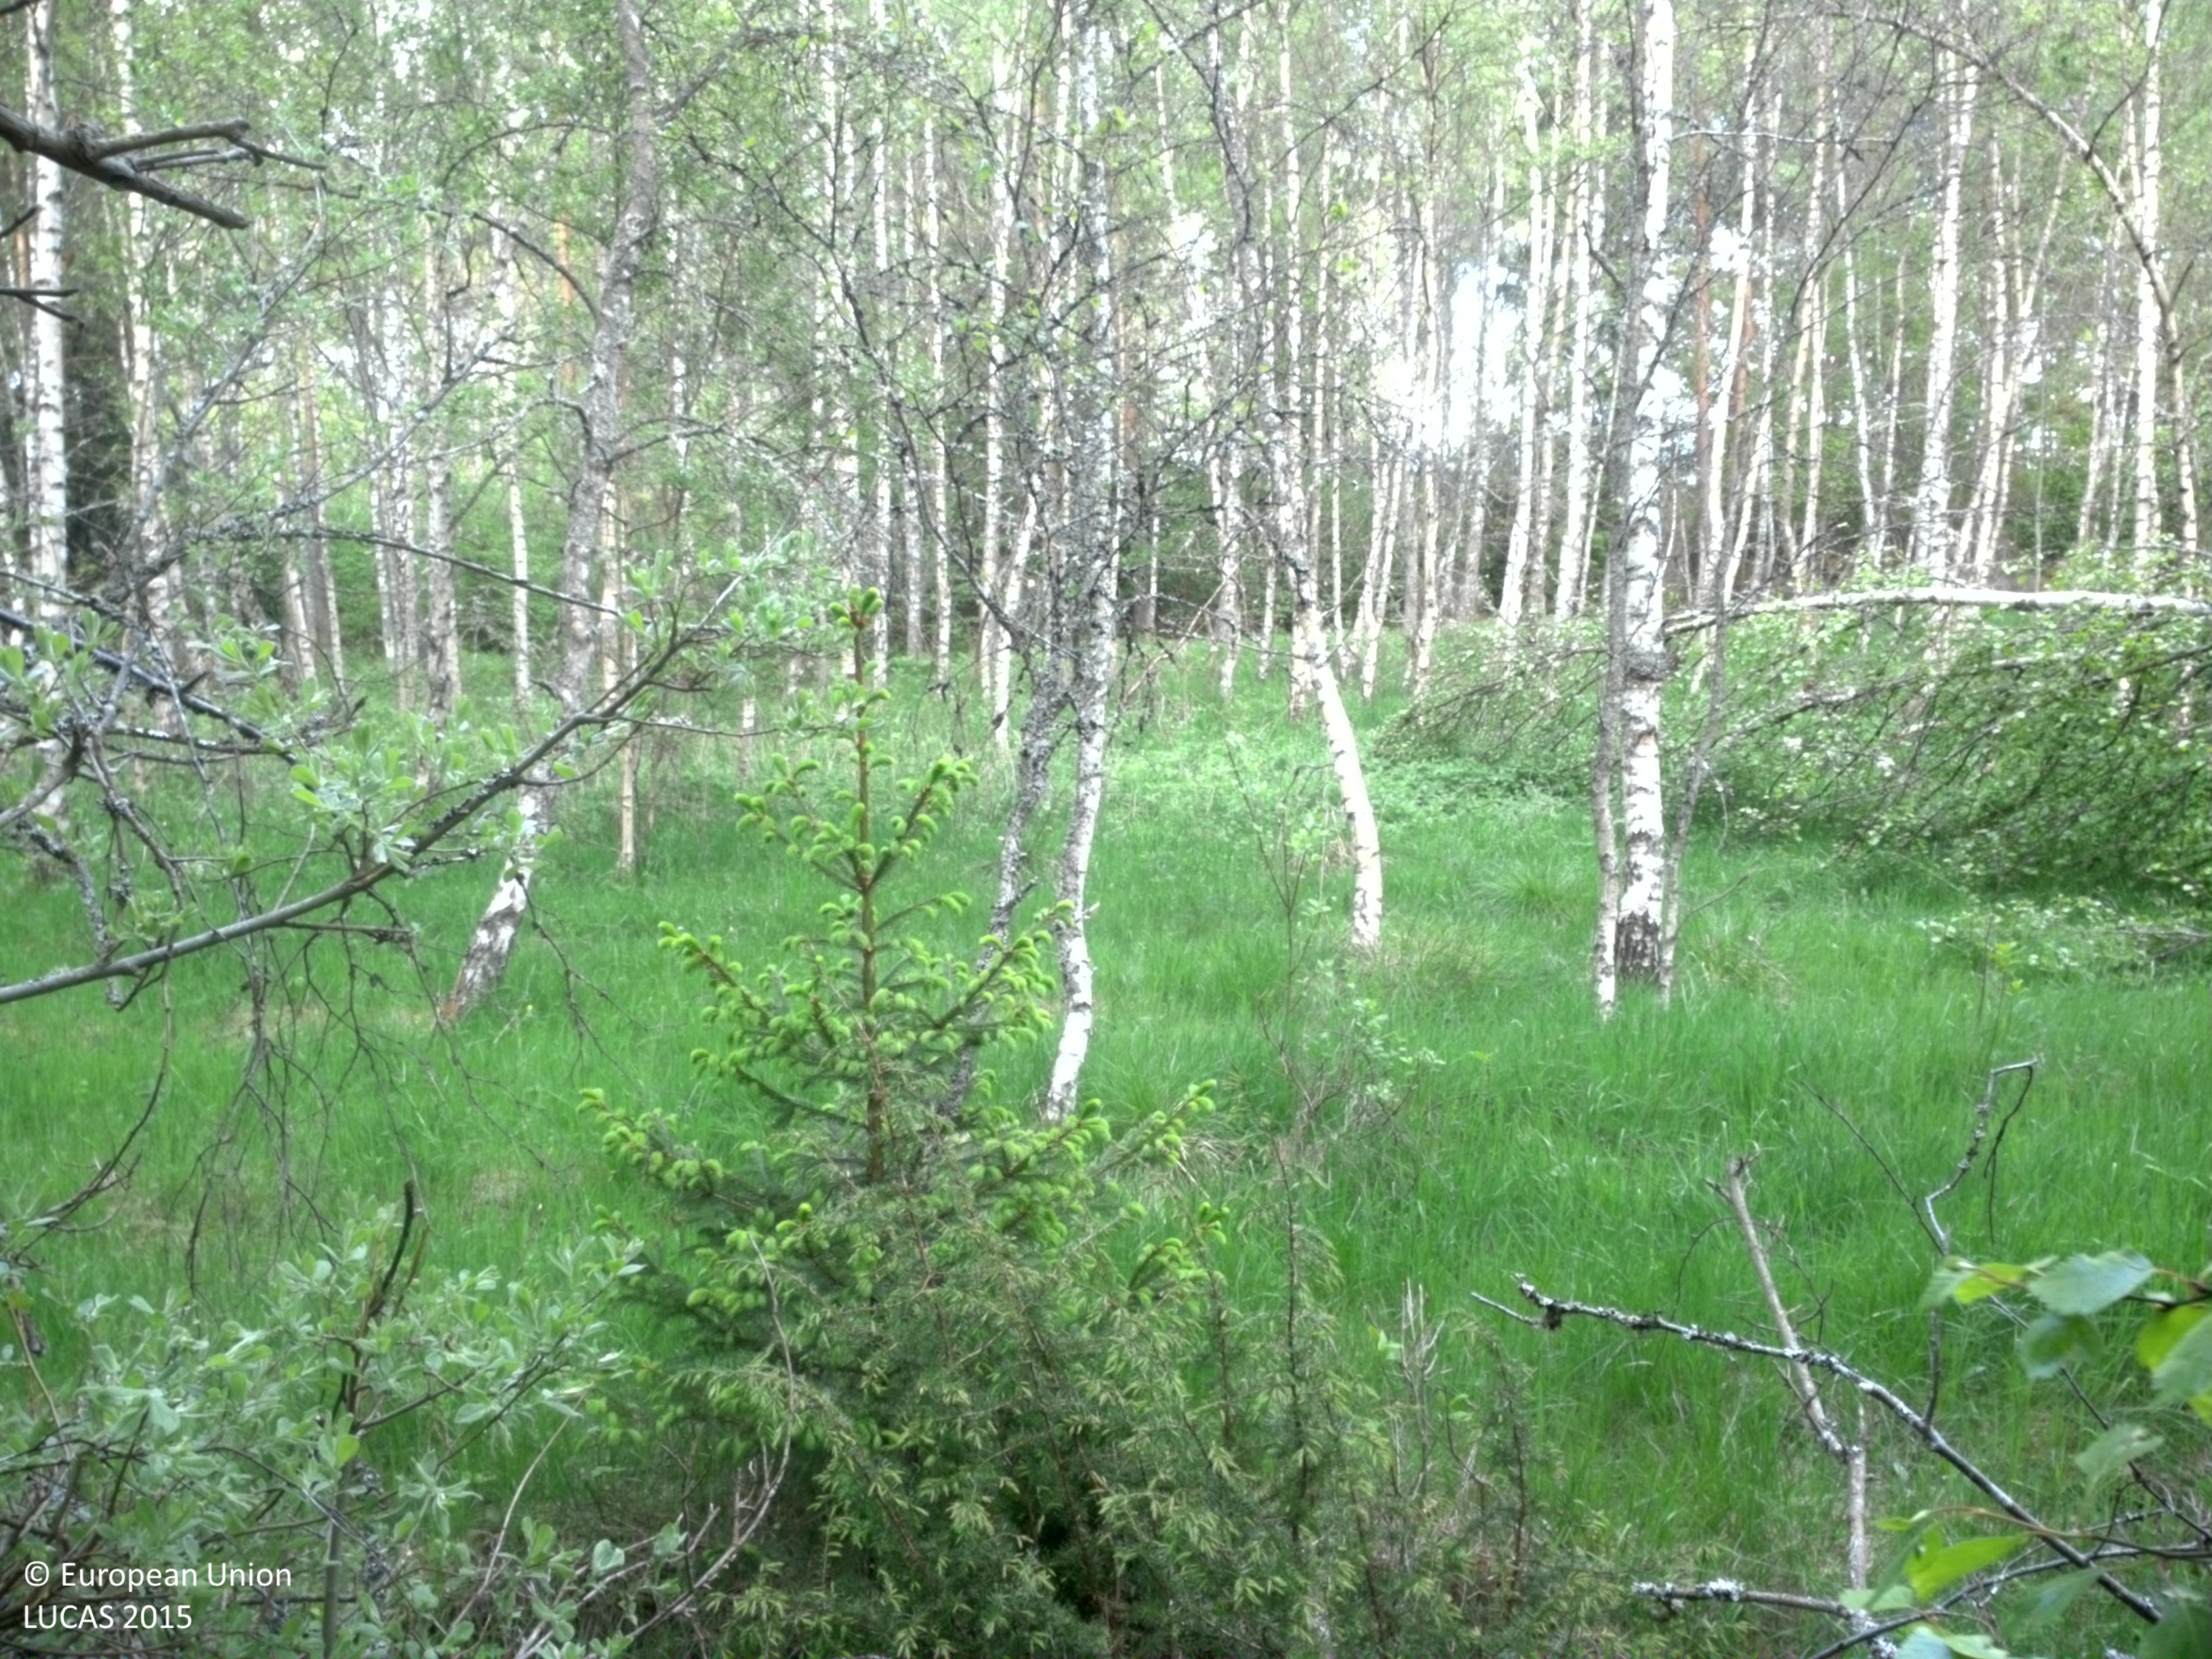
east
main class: Woodland
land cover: Broadleaved woodland
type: boreal forest
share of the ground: 50 - 75 %
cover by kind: broadleaved forest trees 50 %, herbaceous plants 15 %, lichens and mosses 15 %, coniferous forest trees 10 %, shrubs 10 %
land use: Forestry
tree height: > 5 m
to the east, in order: Ditches and canals; Broadleaved woodland; Dry stone walls; Broadleaved woodland; Tracks; Broadleaved woodland; Grassland with sparse tree/shrub cover; Broadleaved woodland; Shrubland with sparse tree cover; Broadleaved woodland; Shrubland with sparse tree cover; Spruce dominated coniferous woodland
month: May
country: SE
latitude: 57.3132
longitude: 15.9252
